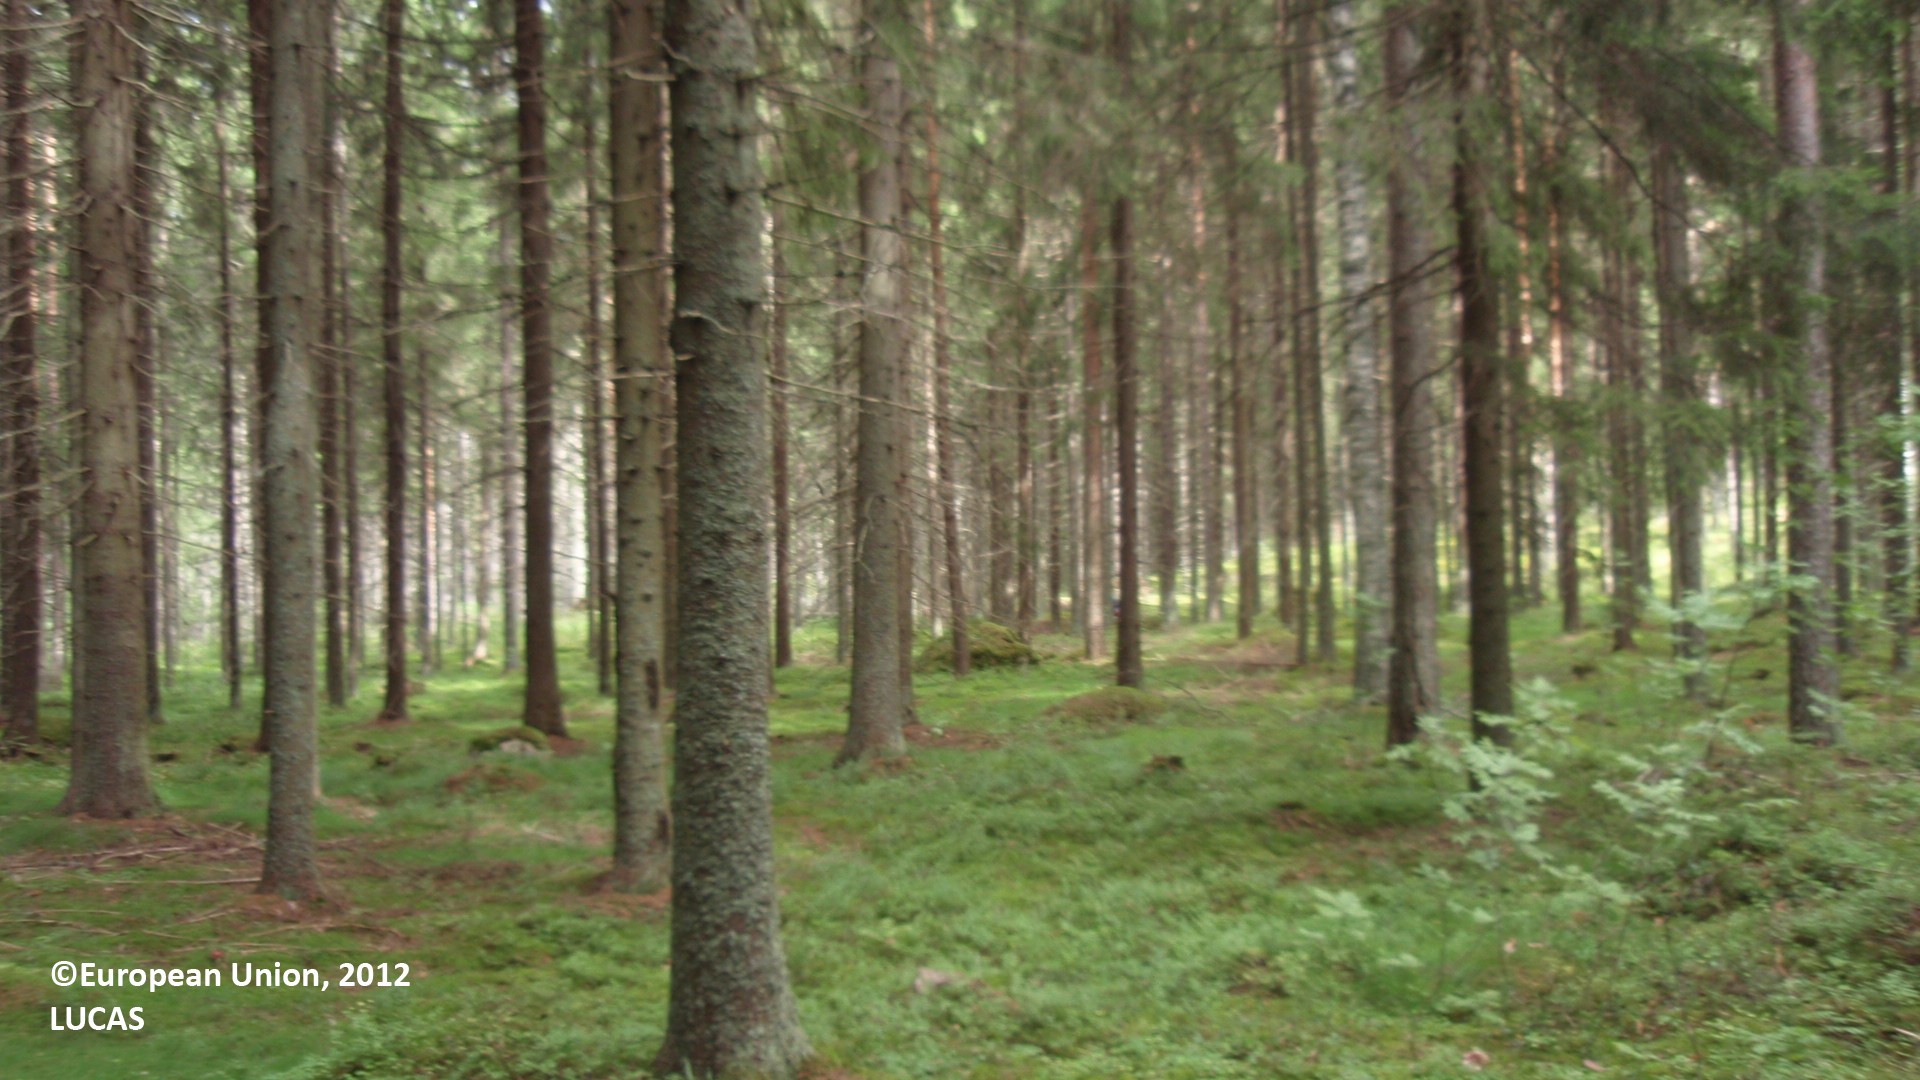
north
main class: Woodland
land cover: Spruce dominated mixed woodland
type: boreal forest
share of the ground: 50 - 75 %
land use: Agriculture (excluding fallow land and kitchen gardens)
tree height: > 5 m
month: August
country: FI
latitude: 61.0373
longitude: 27.4908
